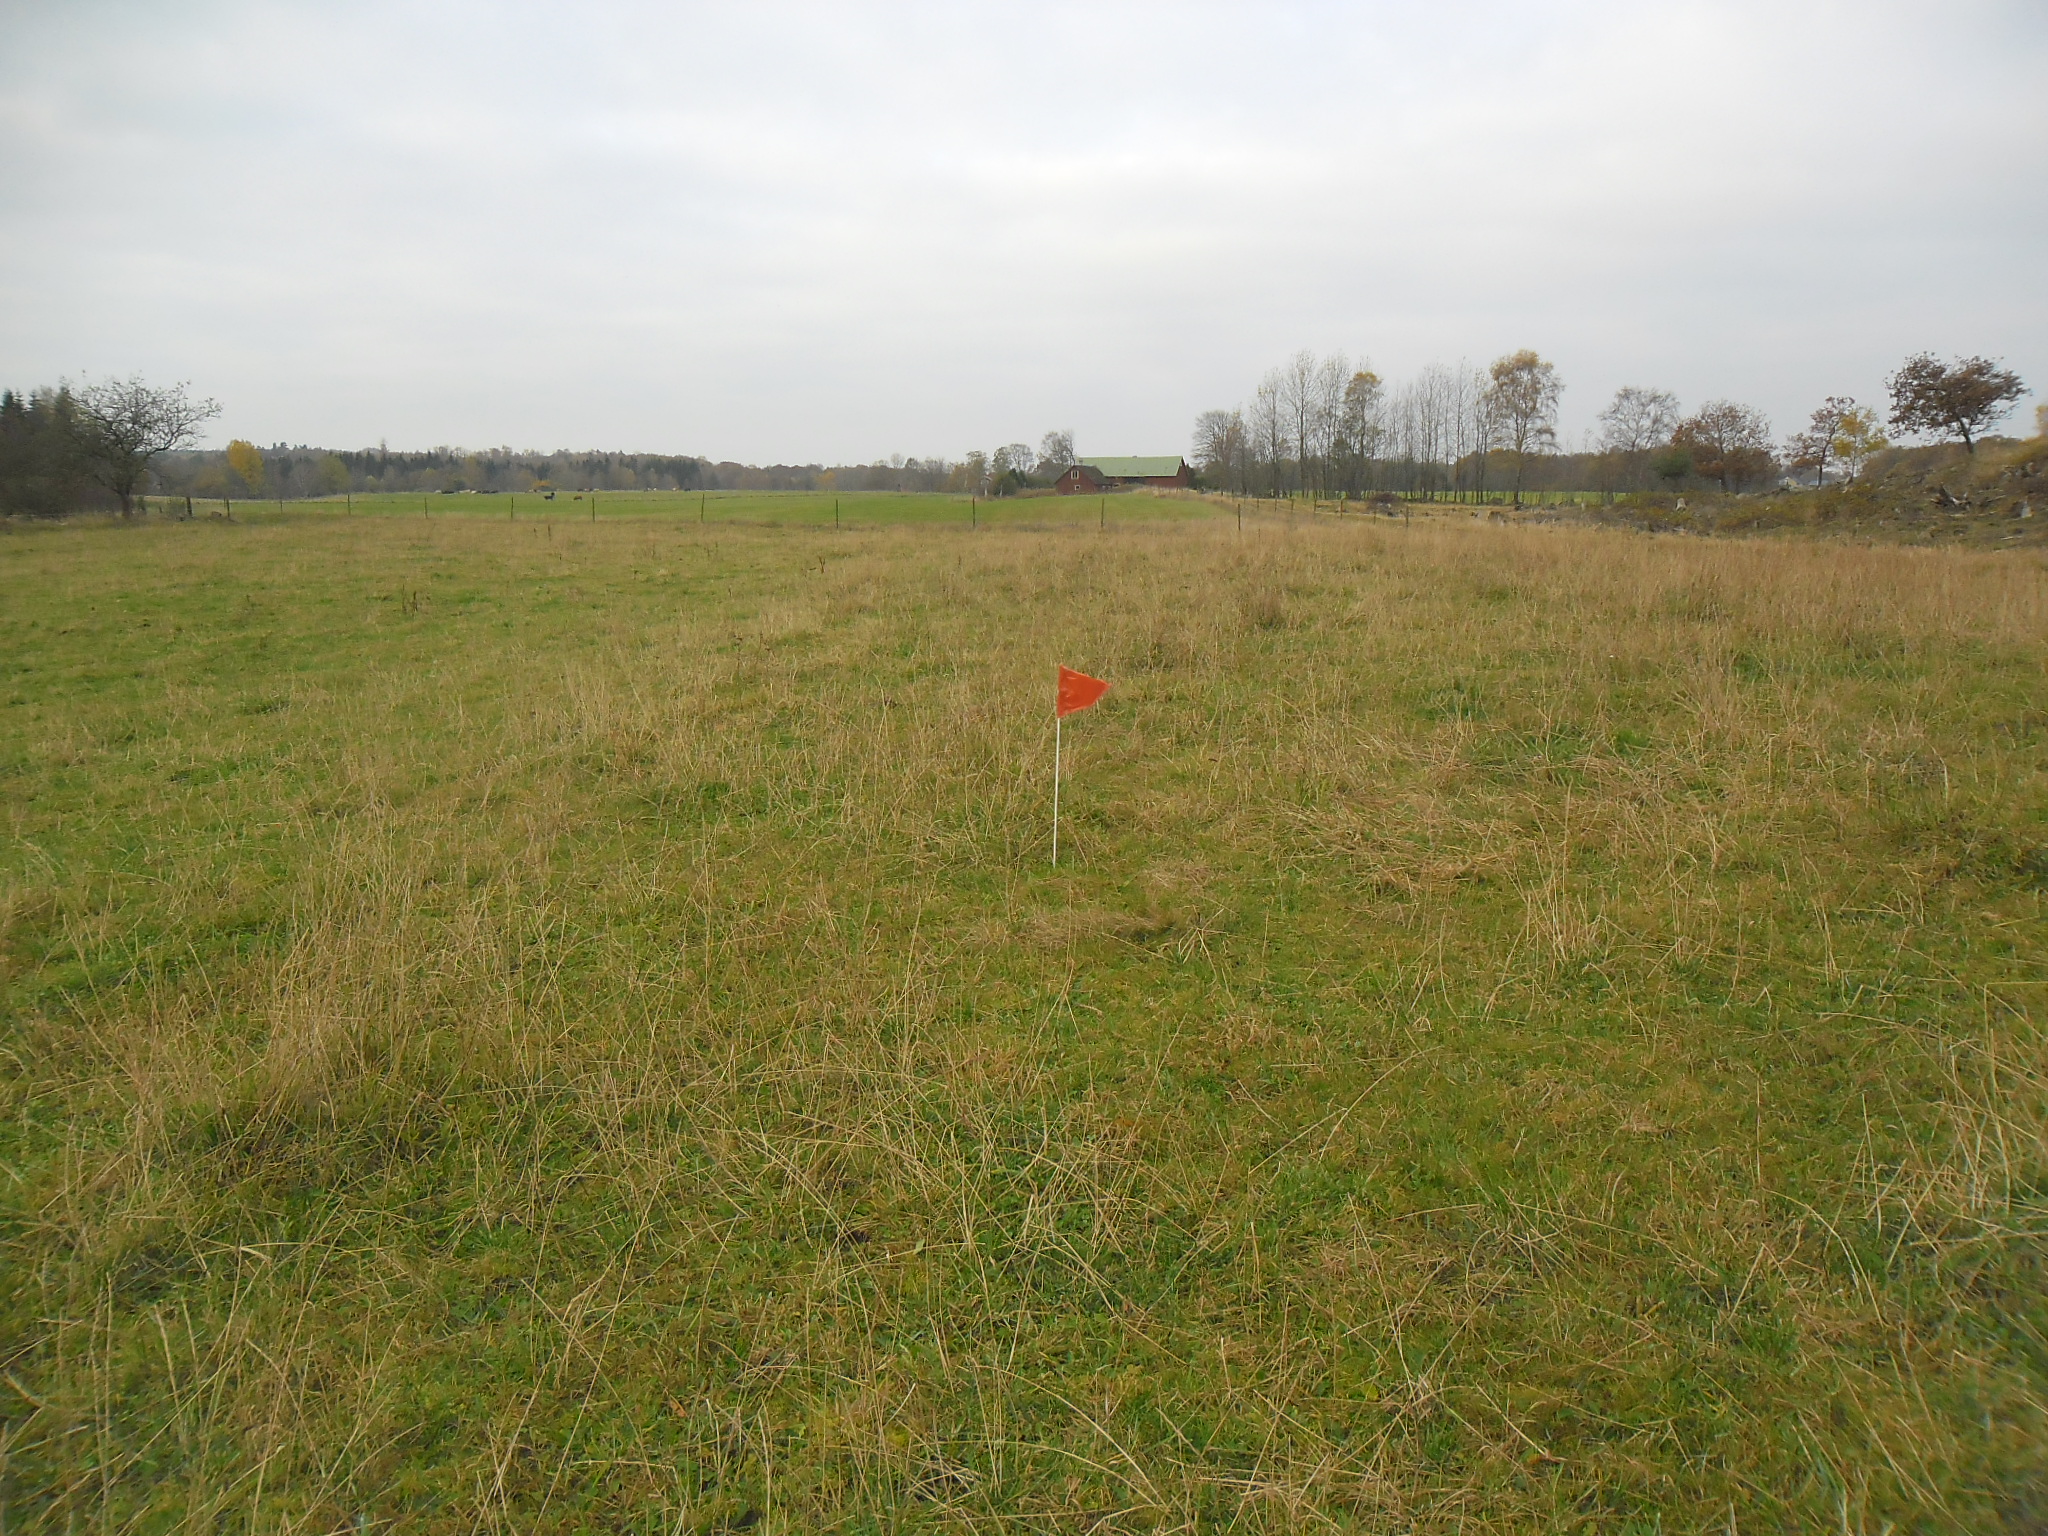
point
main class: Cropland
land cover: Temporary grasslands
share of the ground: > 75 %
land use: Agriculture (excluding fallow land and kitchen gardens)
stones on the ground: 25 - 50 %
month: October
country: SE
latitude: 56.5258
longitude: 13.1995
